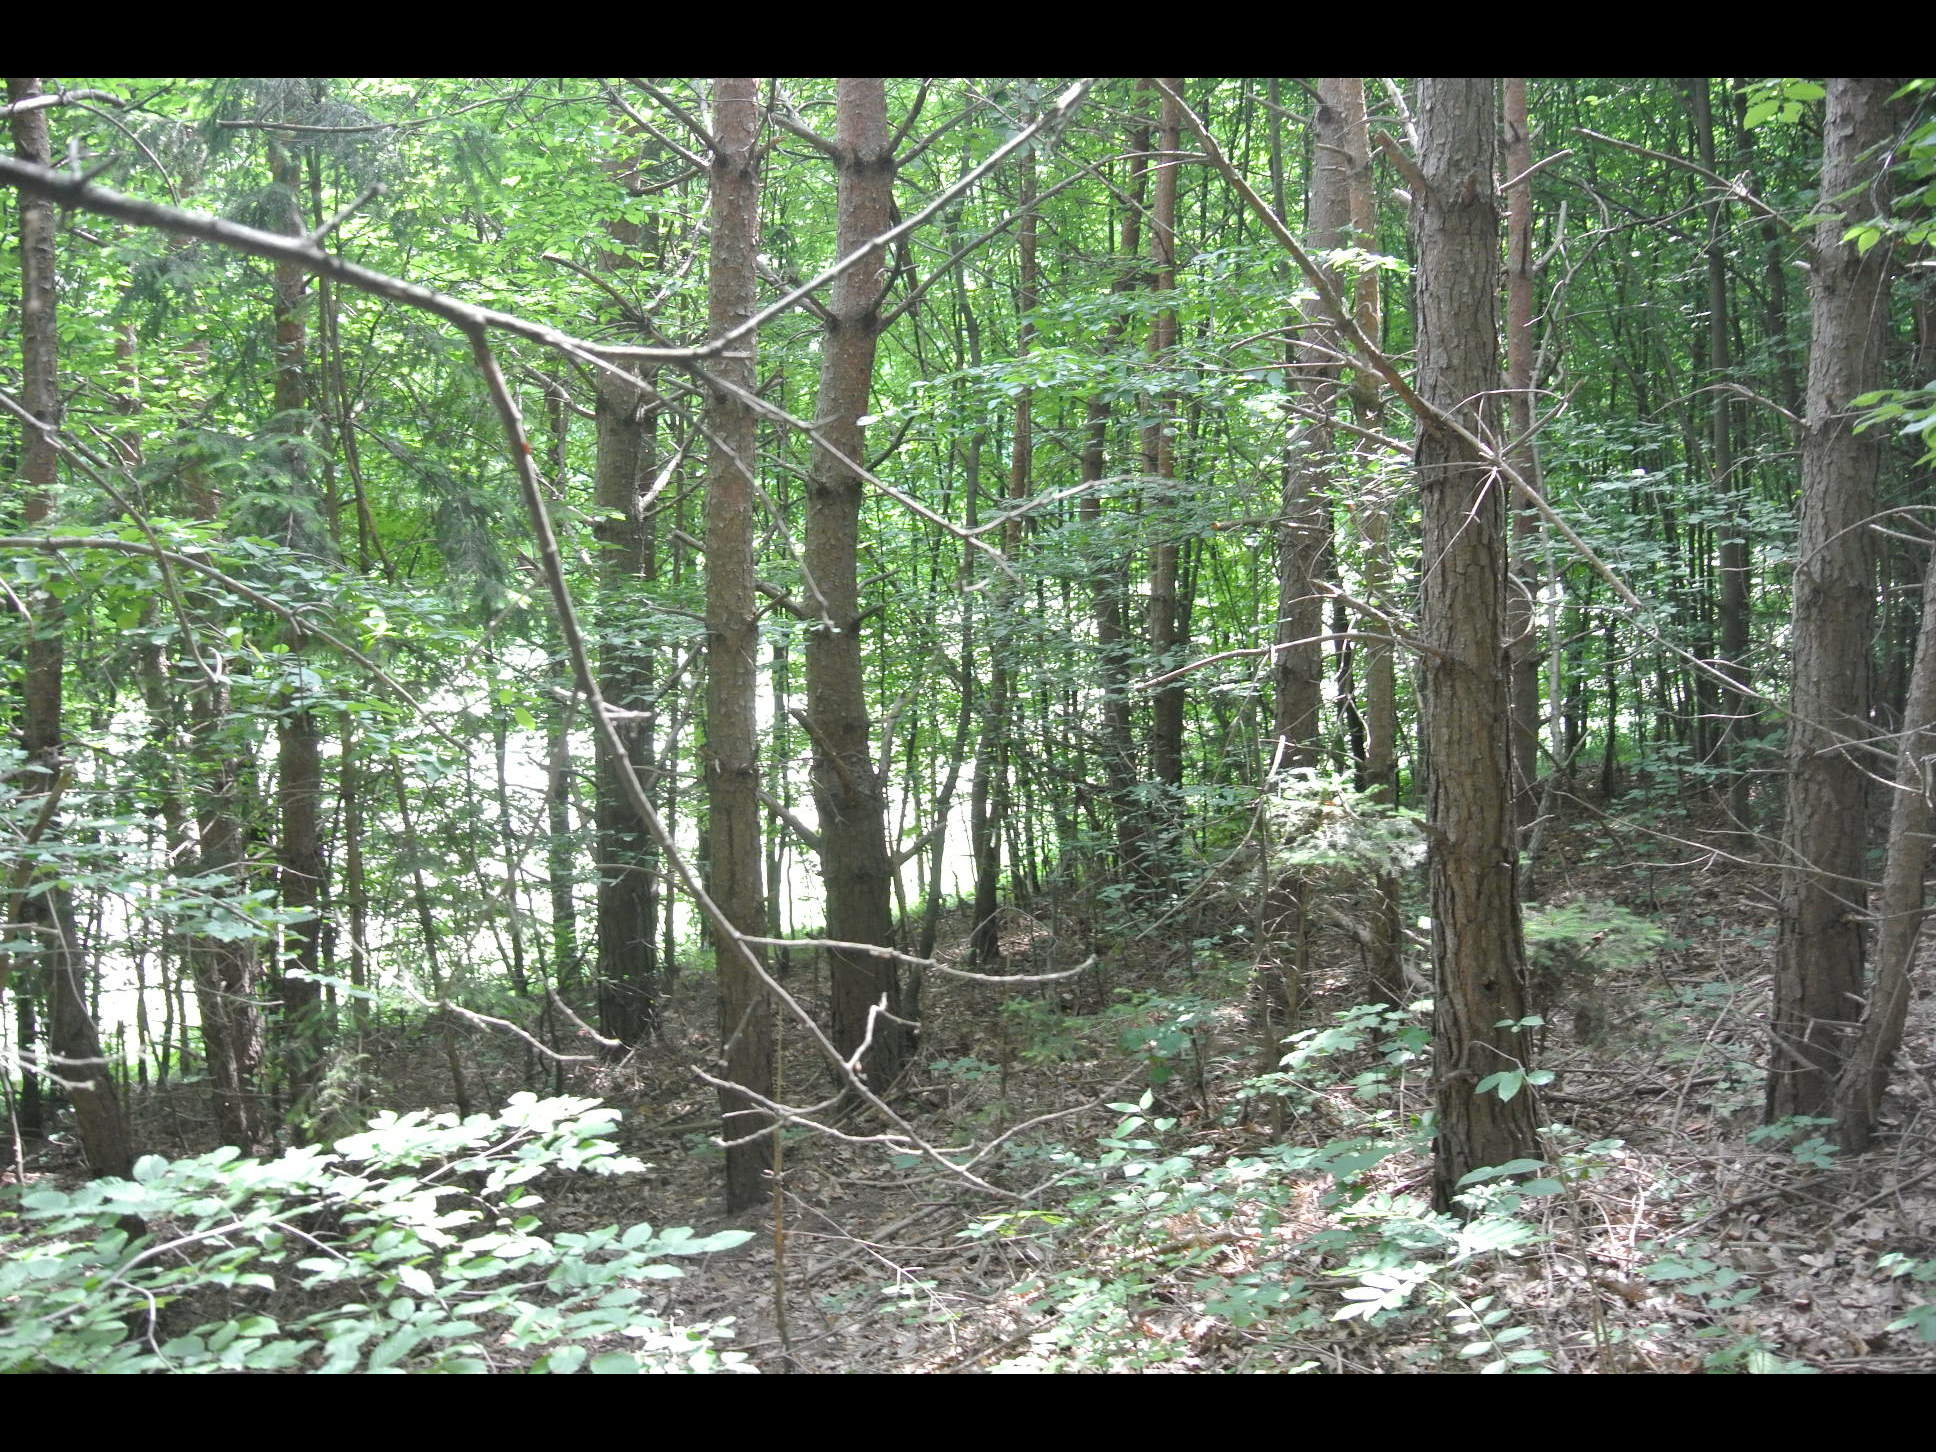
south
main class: Woodland
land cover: Pine dominated mixed woodland
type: alpine coniferous forest
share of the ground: > 75 %
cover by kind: coniferous forest trees 75 %, broadleaved forest trees 25 %
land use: Forestry
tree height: > 5 m
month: June
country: AT
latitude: 48.0362
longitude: 16.1062
